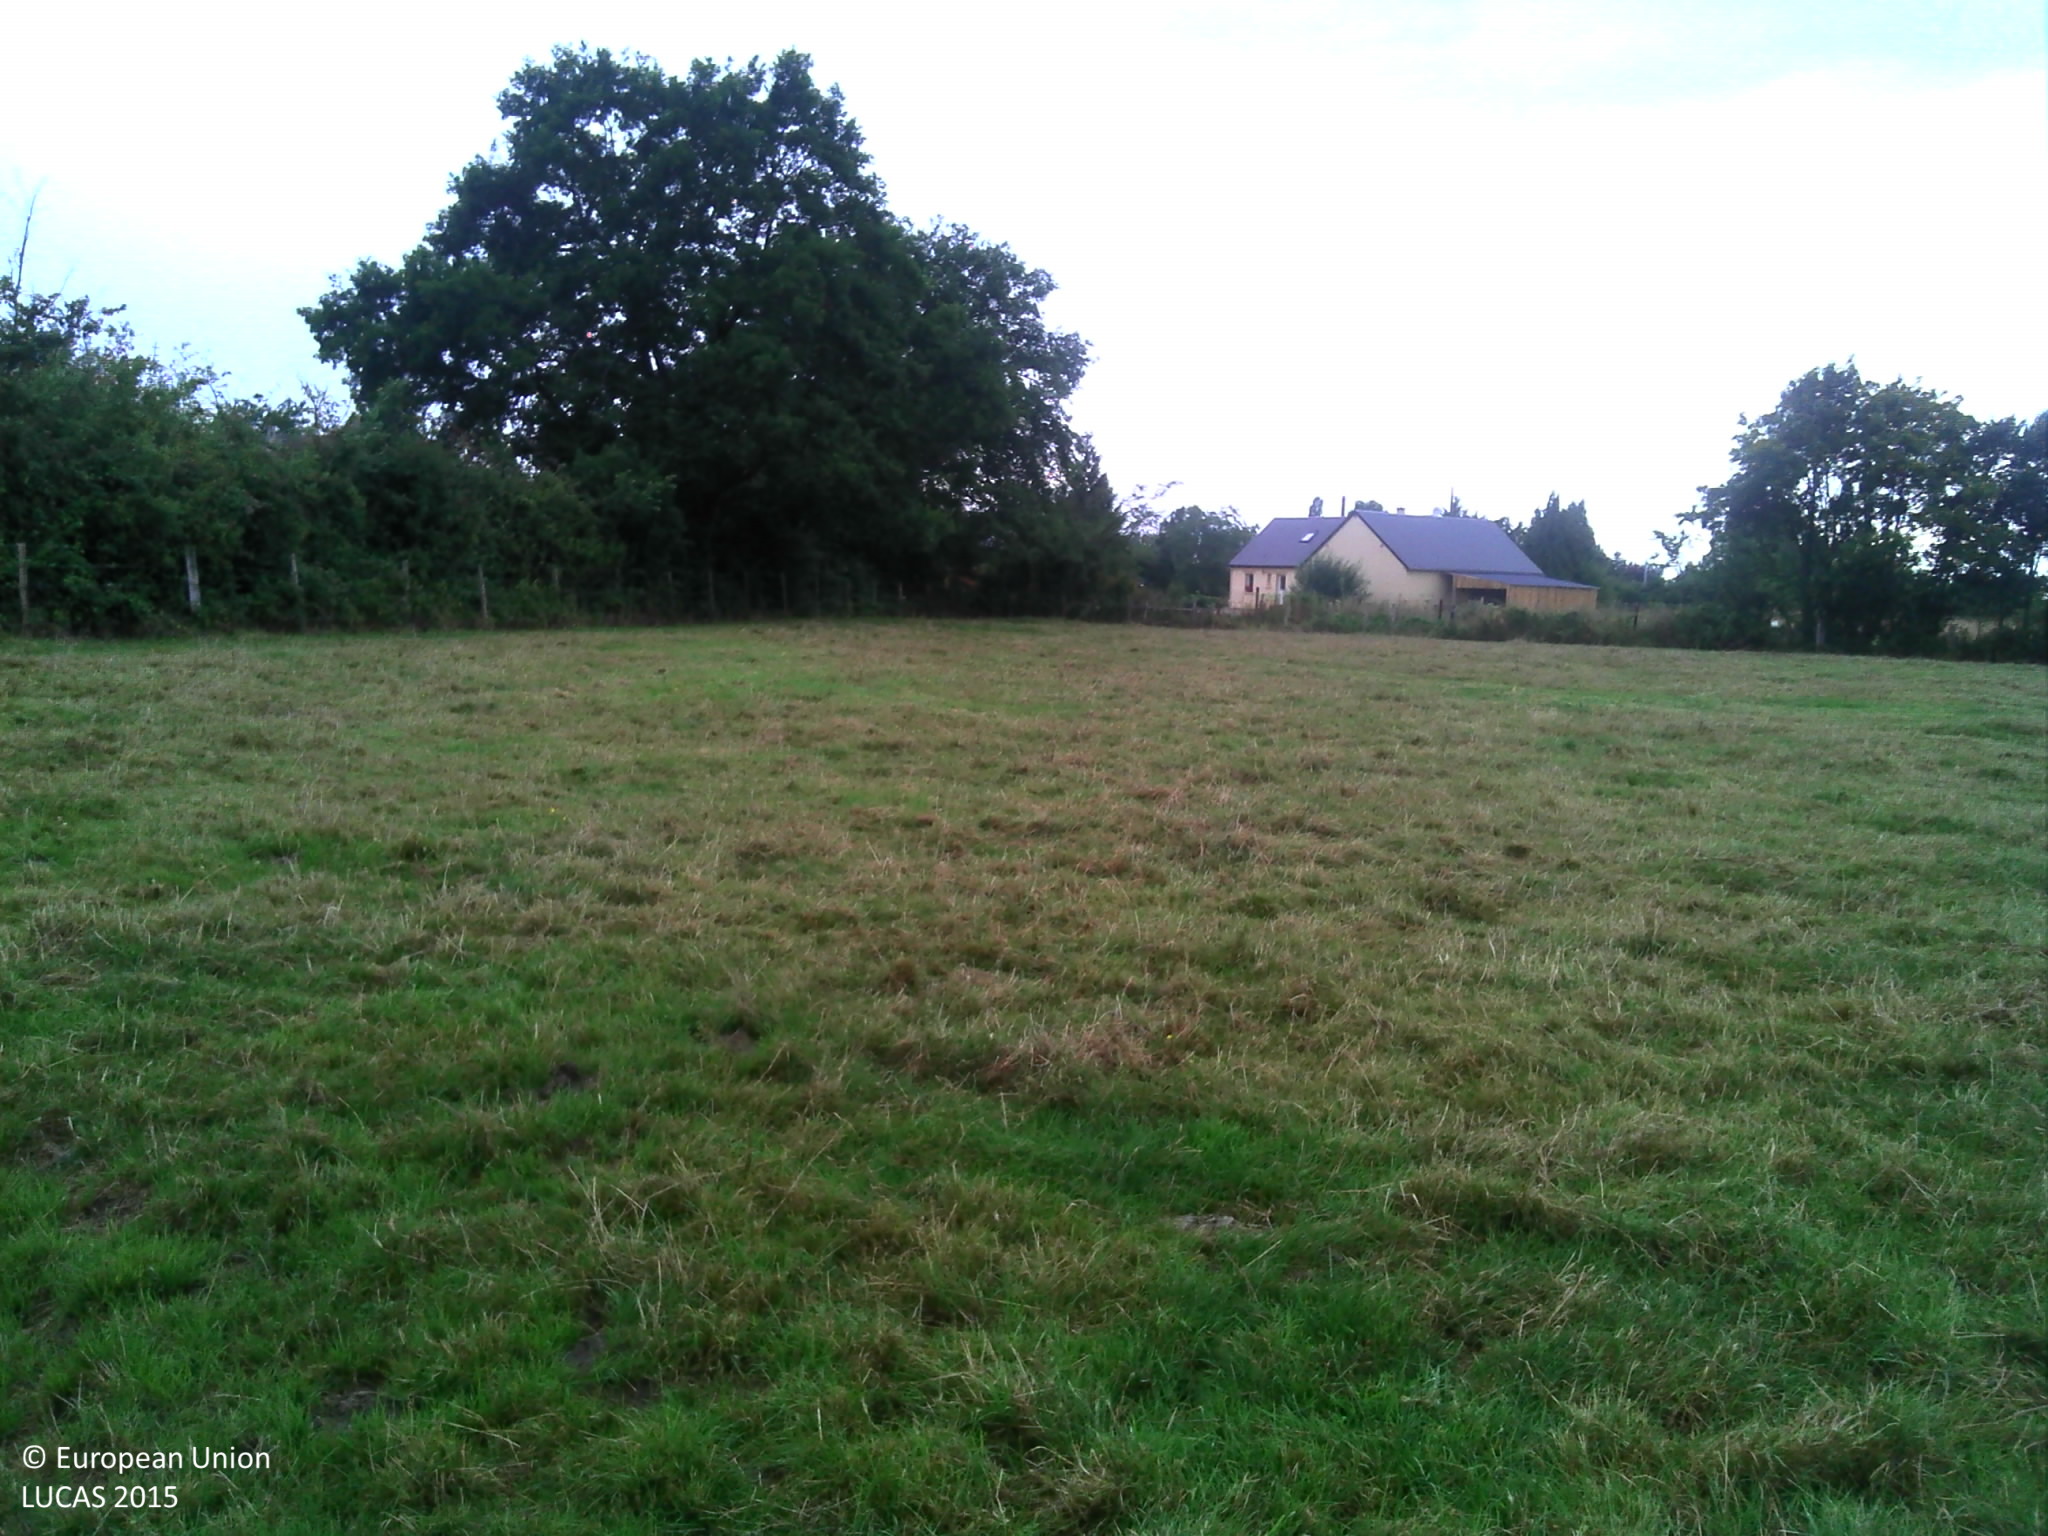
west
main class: Grassland
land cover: Grassland without tree/shrub cover
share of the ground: > 75 %
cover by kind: herbaceous plants 100 %
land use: Agriculture (excluding fallow land and kitchen gardens)
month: July
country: FR
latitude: 49.1101
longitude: 0.0099
